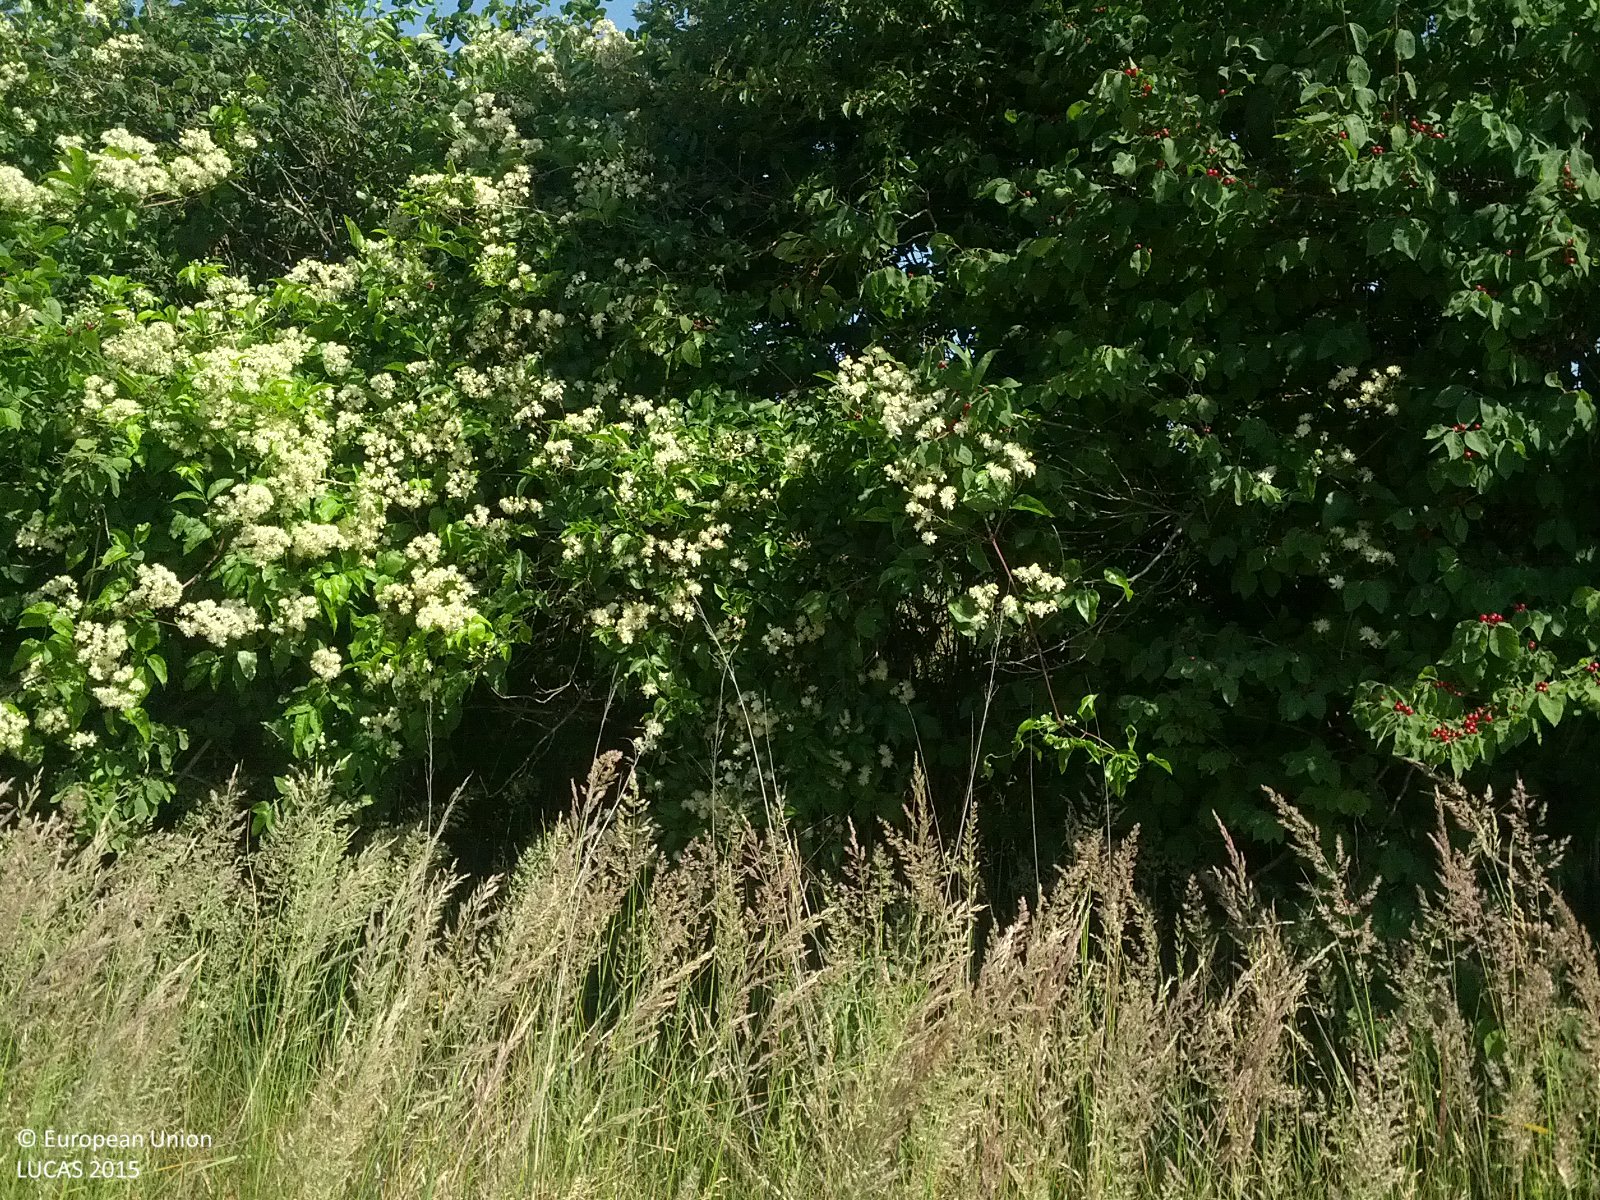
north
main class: Cropland
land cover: Common wheat
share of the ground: > 75 %
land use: Agriculture (excluding fallow land and kitchen gardens)
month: July
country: AT
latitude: 48.6270
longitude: 16.5052
